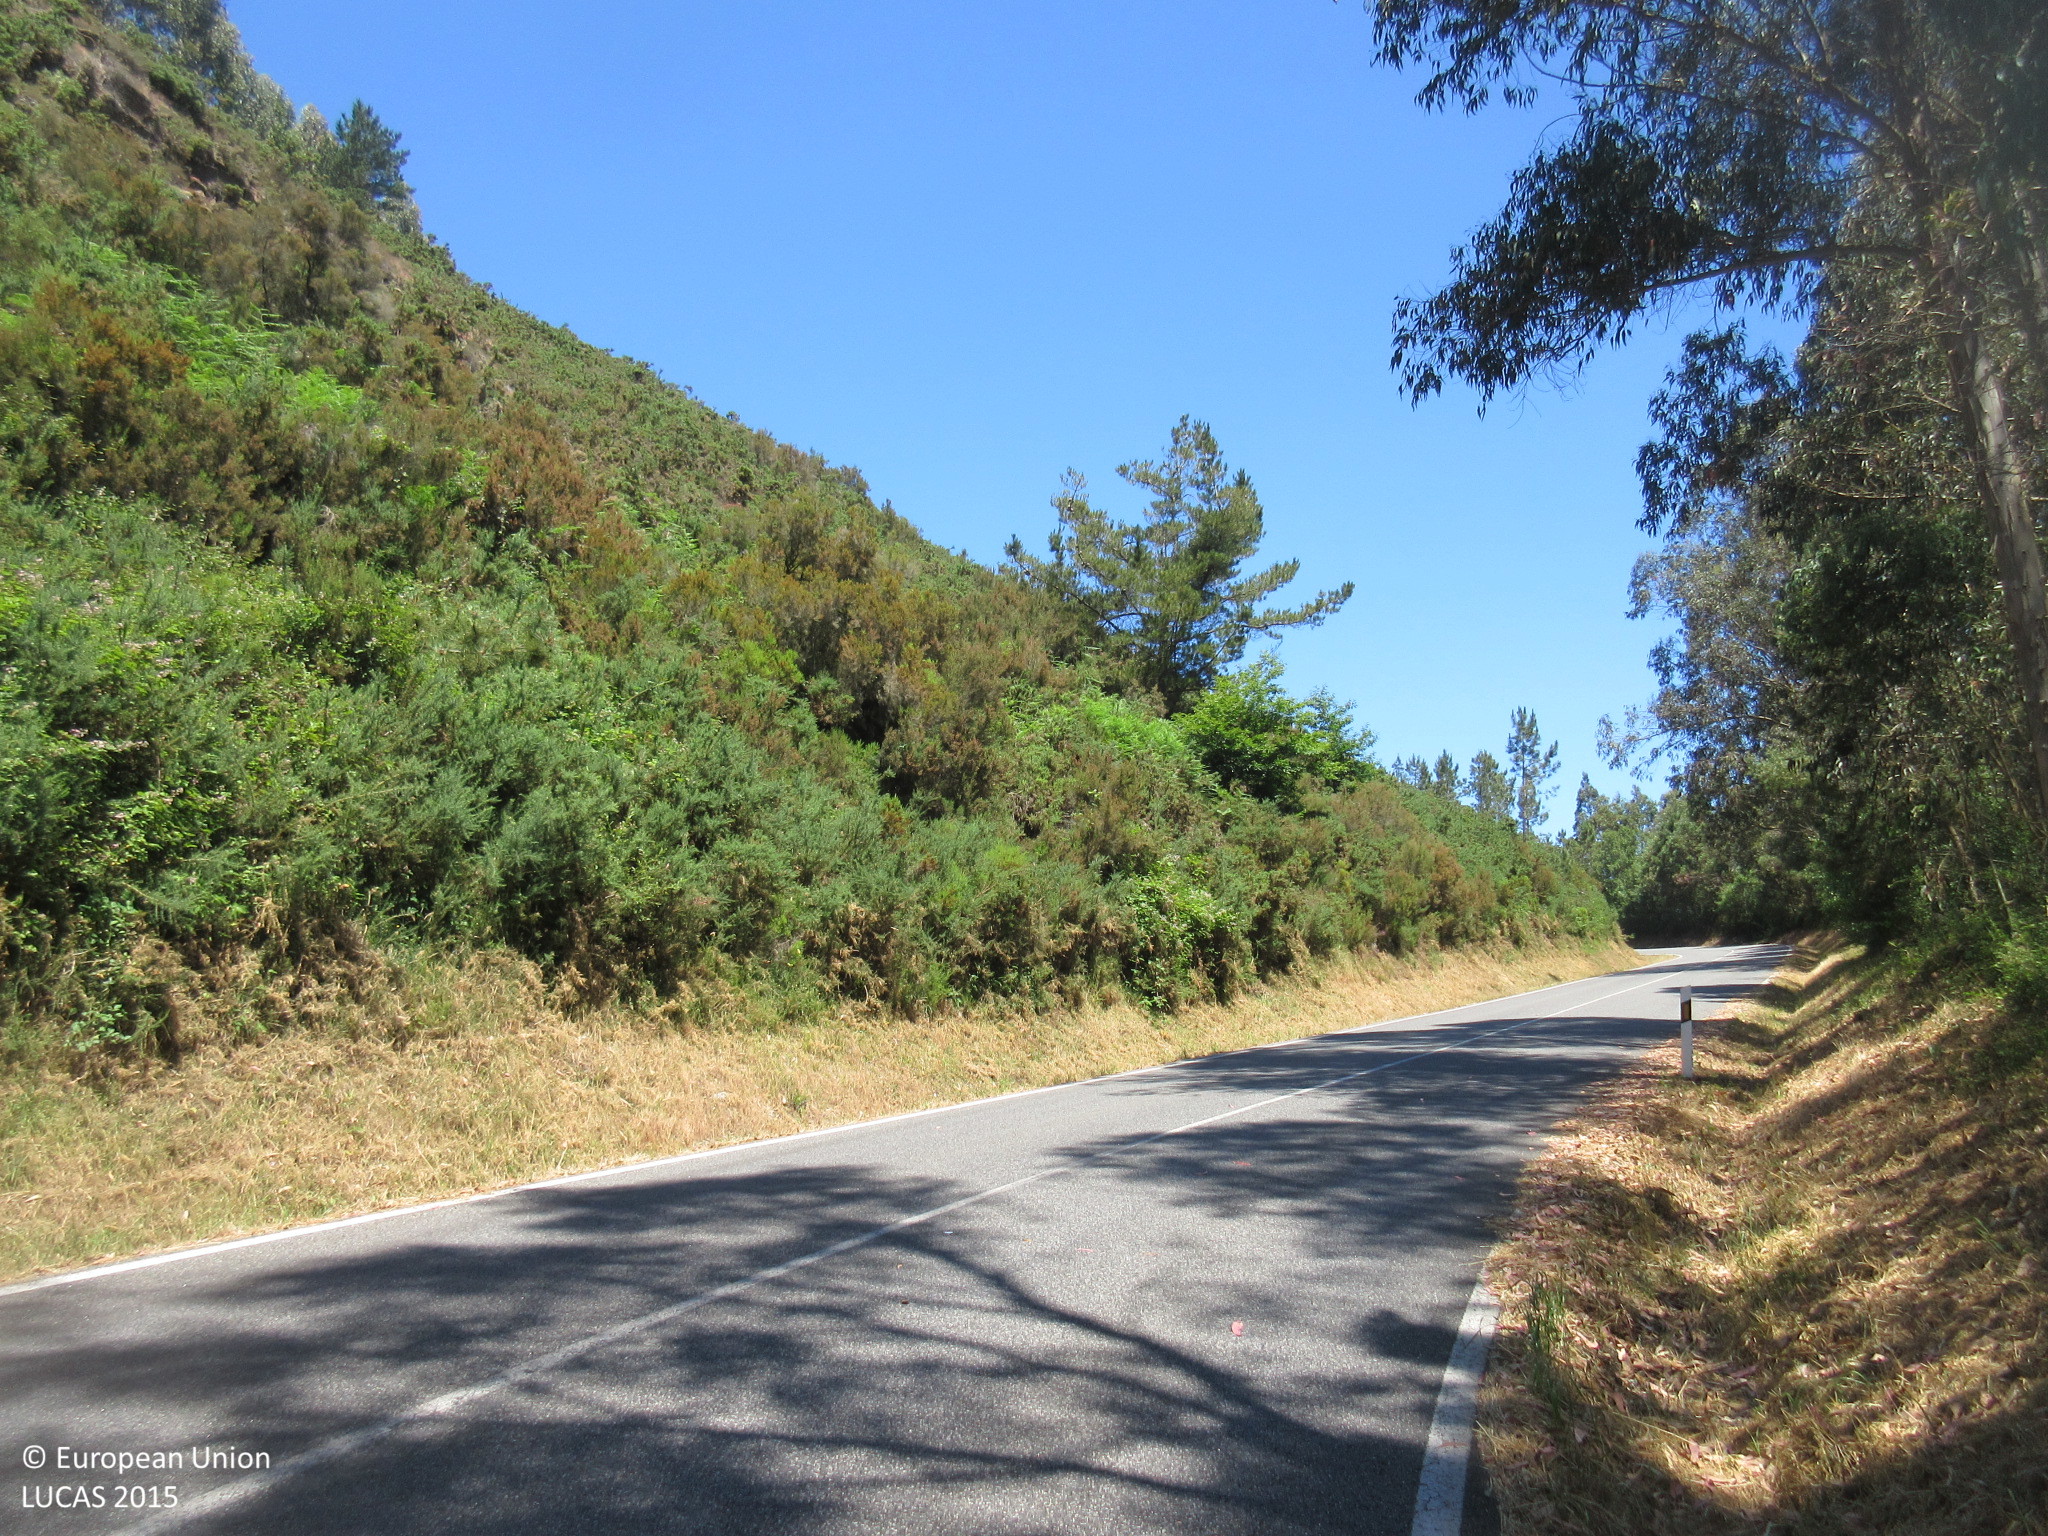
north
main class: Woodland
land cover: Broadleaved woodland
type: exotic forest
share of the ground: > 75 %
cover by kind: broadleaved forest trees 95 %, shrubs 5 %
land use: Forestry
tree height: > 5 m
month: June
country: ES
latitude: 43.2113
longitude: -7.2168
